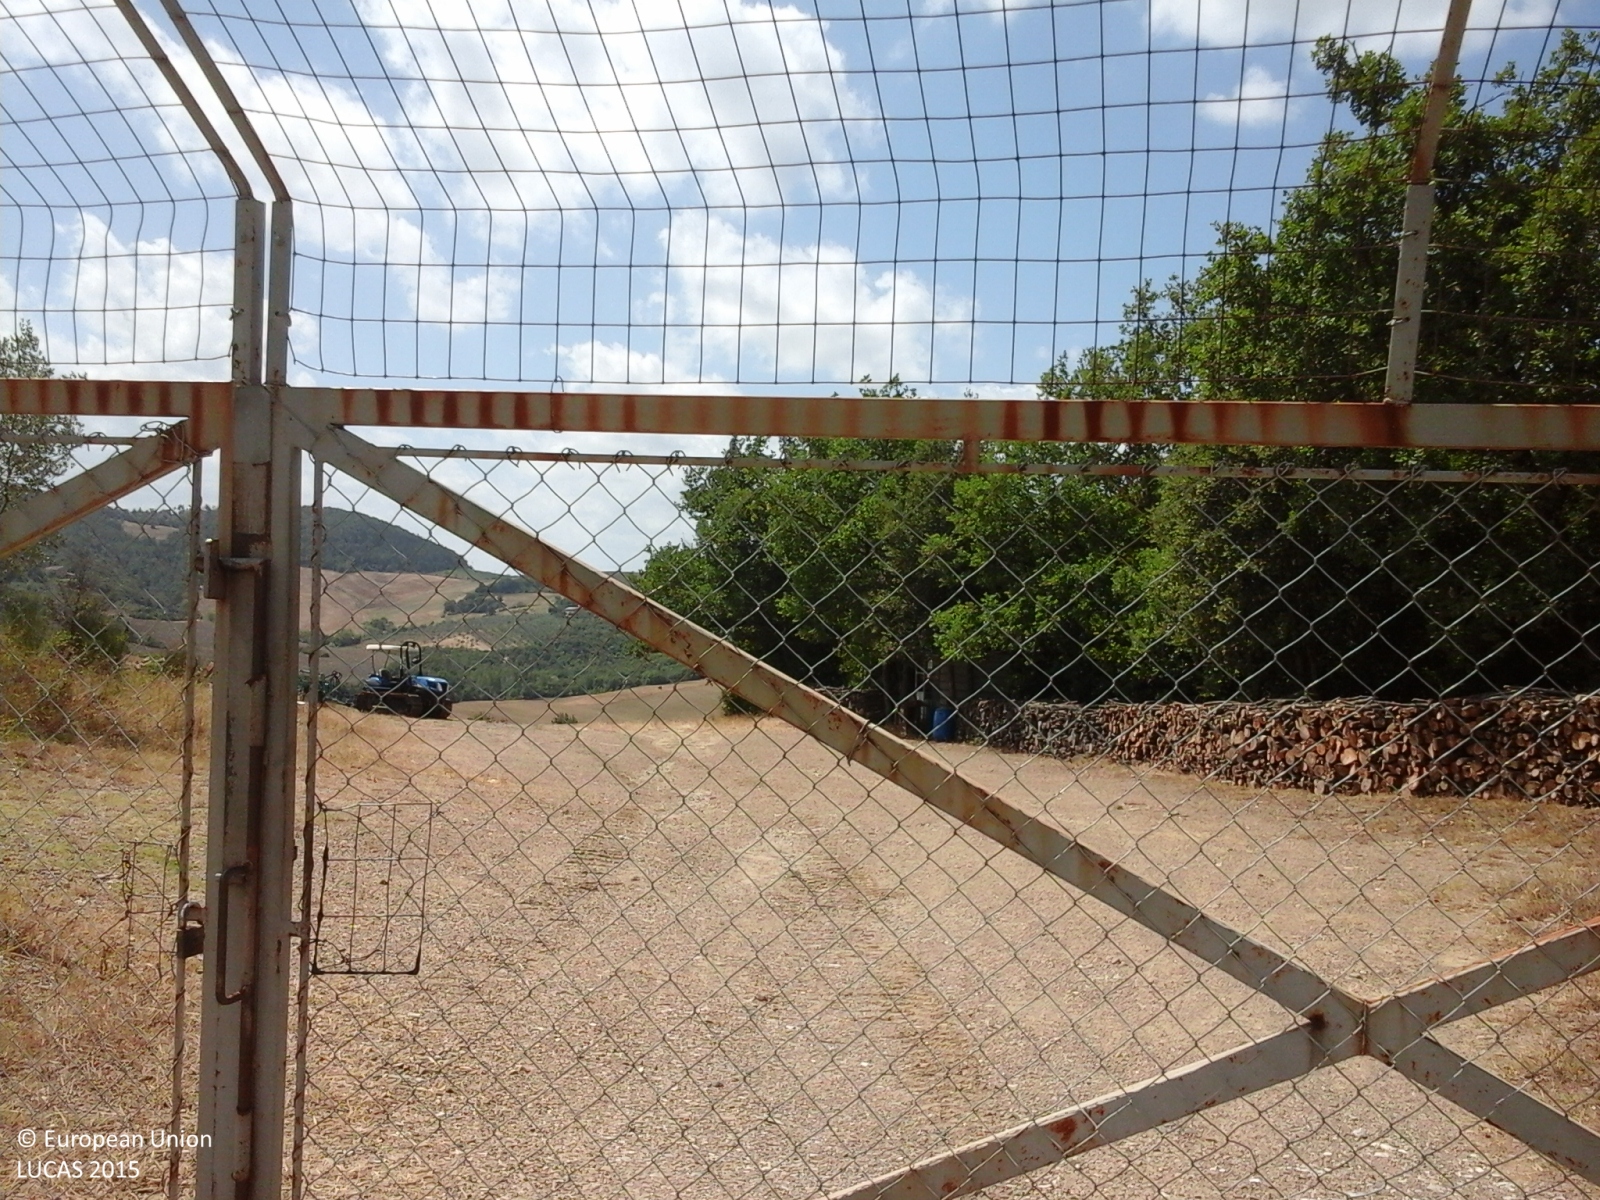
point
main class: Grassland
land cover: Grassland with sparse tree/shrub cover
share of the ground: > 75 %
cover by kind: herbaceous plants 85 %, shrubs 10 %, broadleaved forest trees 5 %
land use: Agriculture (excluding fallow land and kitchen gardens)
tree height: < 5 m
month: February
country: IT
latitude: 43.4443
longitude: 10.9241
